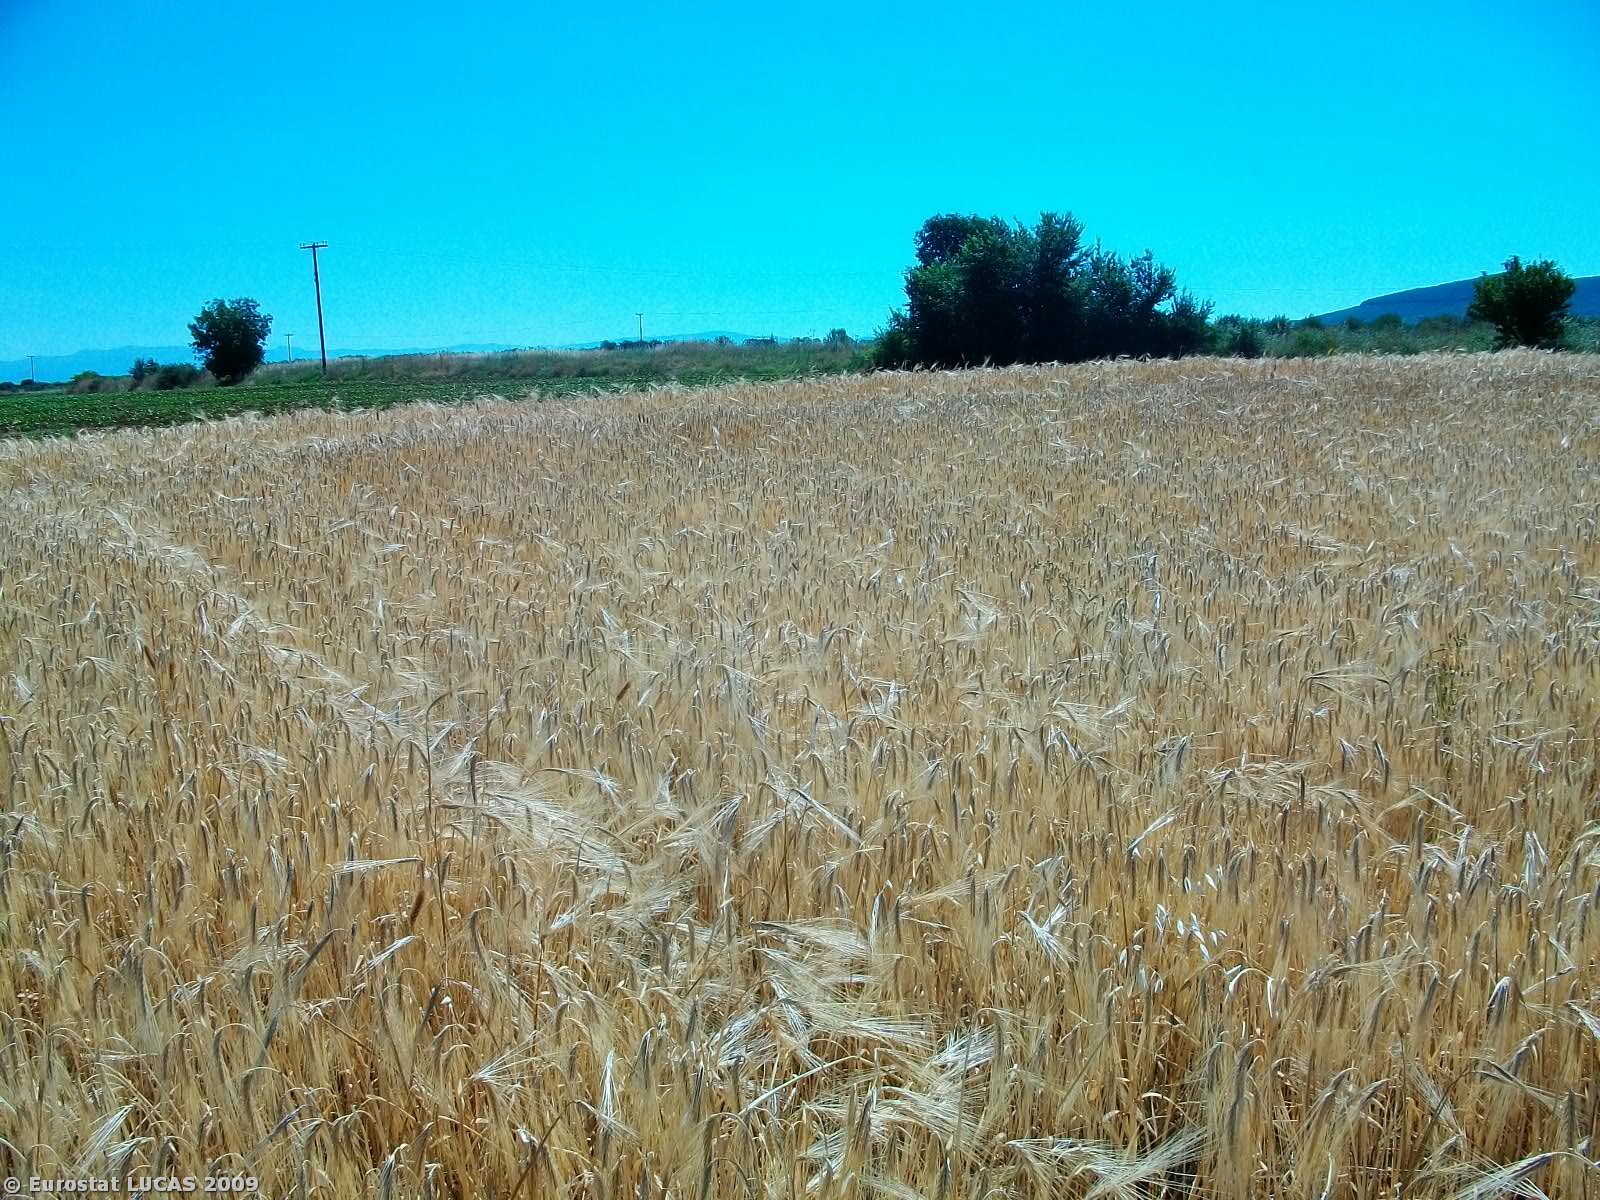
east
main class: Cropland
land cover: Barley
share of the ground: > 75 %
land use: Agriculture (excluding fallow land and kitchen gardens)
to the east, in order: Barley; Cotton; Grass margins; Paved roads, cycling and walking lanes; Grass margins; Abandoned hedges; Tracks; Spontaneously vegetated surfaces; Cotton; Electric lines; Cotton; Durum wheat
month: June
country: GR
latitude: 41.0159
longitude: 25.4736
